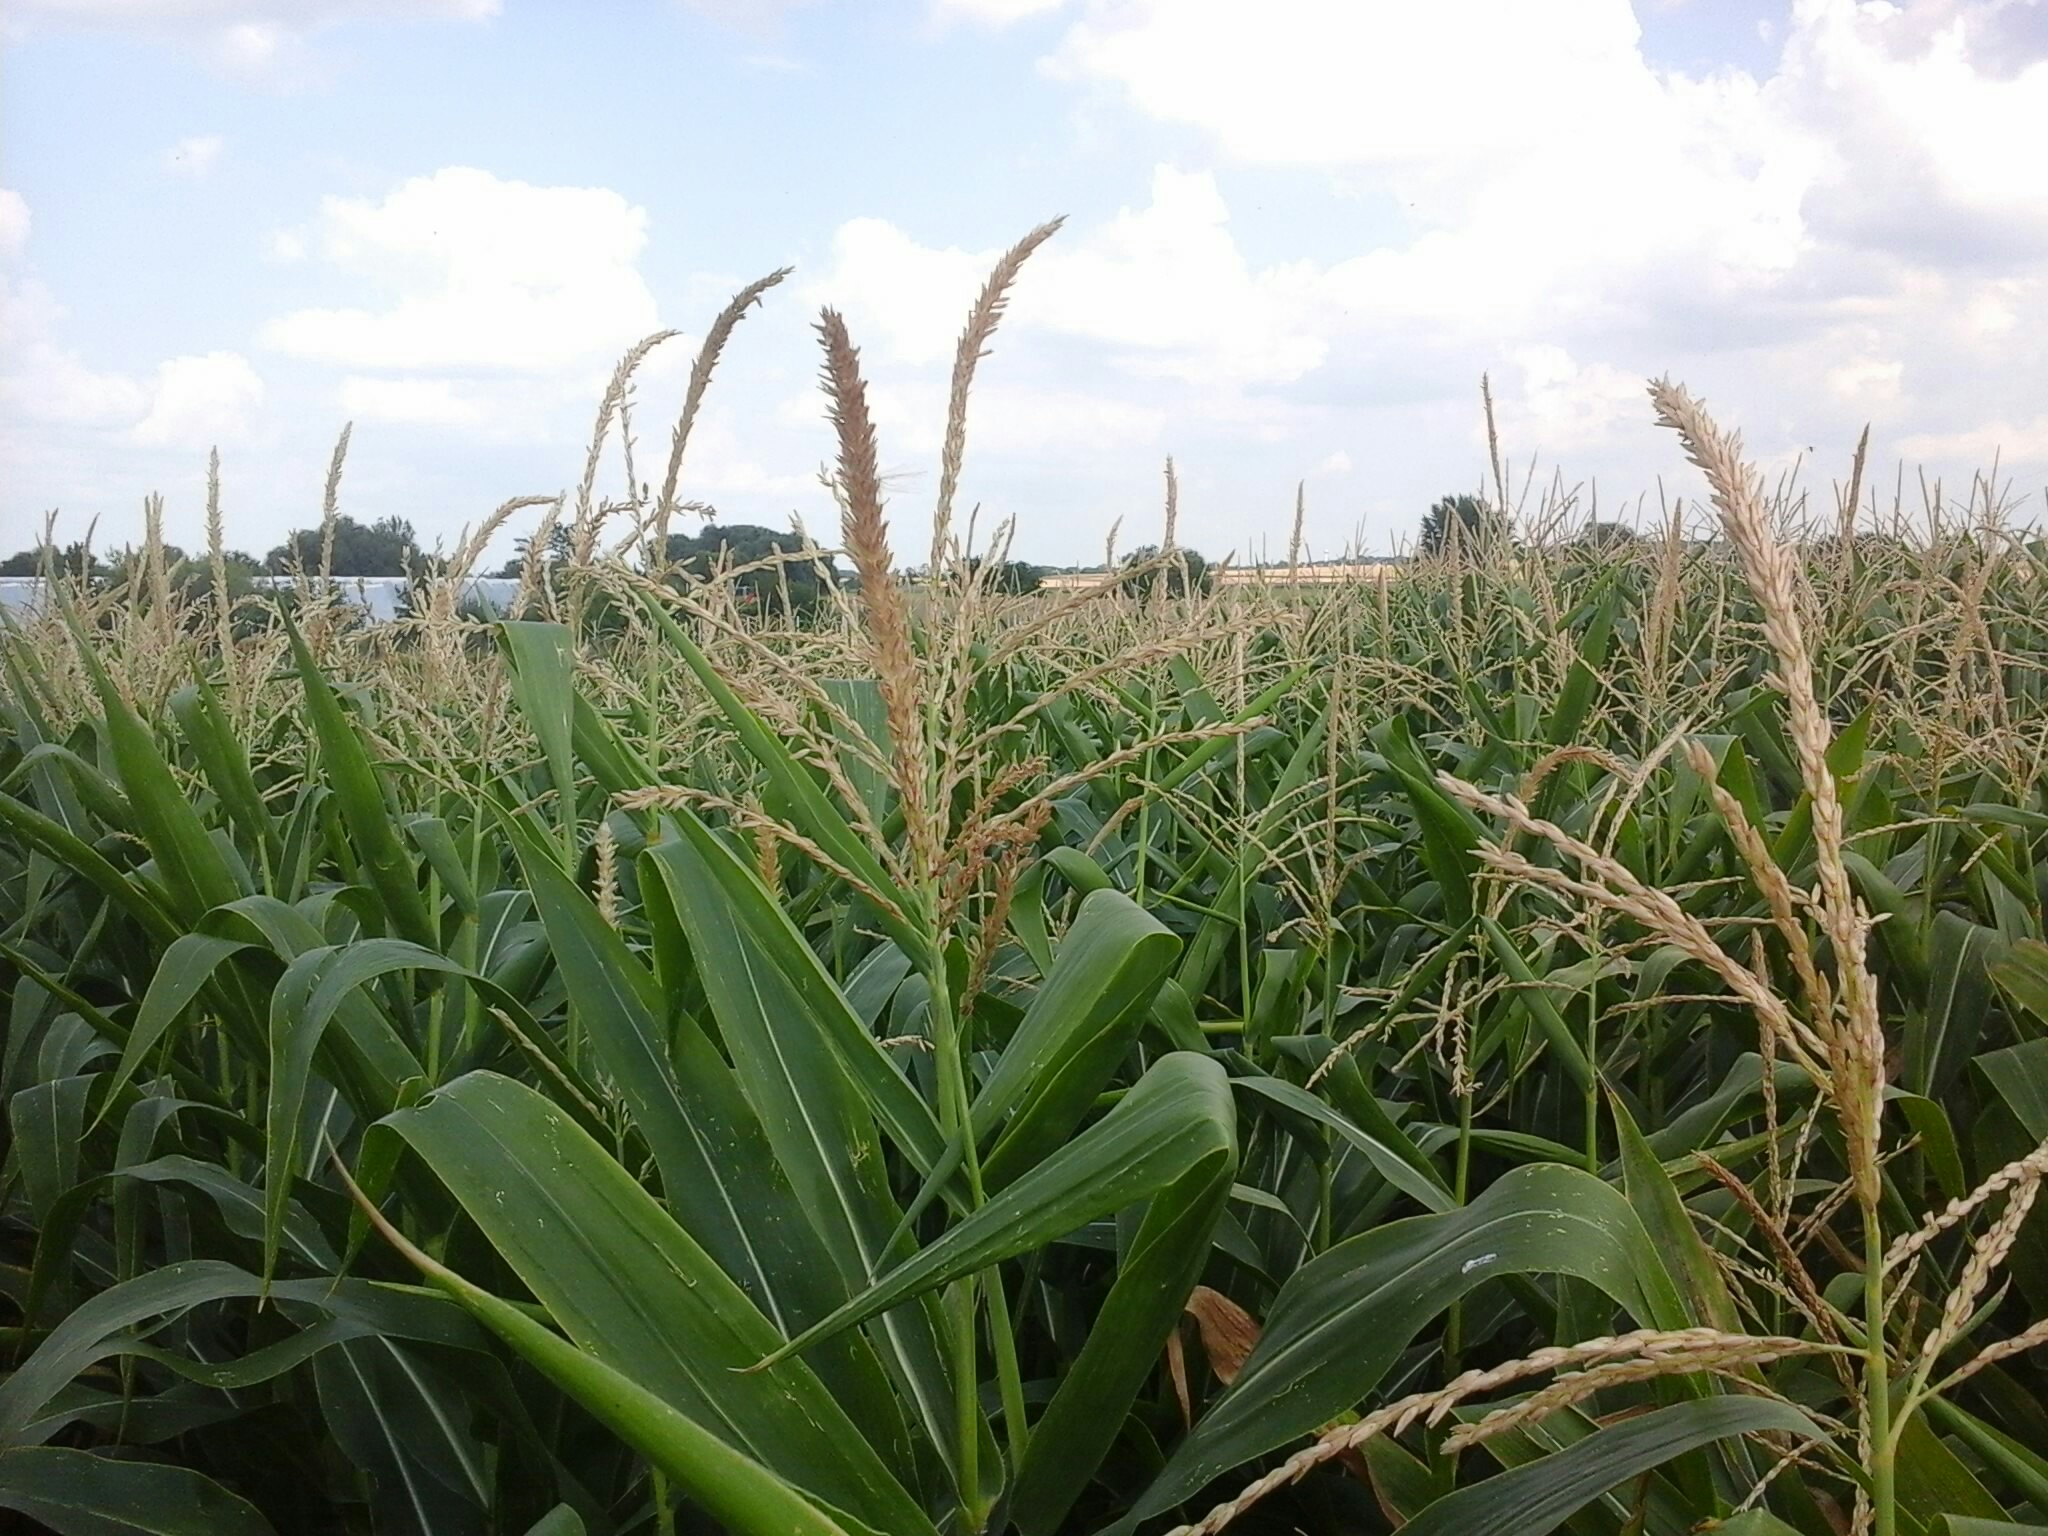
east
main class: Cropland
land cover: Maize
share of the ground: > 75 %
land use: Agriculture (excluding fallow land and kitchen gardens)
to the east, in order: Maize; Electric lines; Maize; Grass margins; Tracks; Grass margins; Other bare soil; Fences; Grassland with sparse tree/shrub cover; Ditches and canals; Grassland with sparse tree/shrub cover; Ditches and canals; Grassland with sparse tree/shrub cover; Fences; Grassland without tree/shrub cover
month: August
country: HU
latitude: 47.5054
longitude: 18.1502
